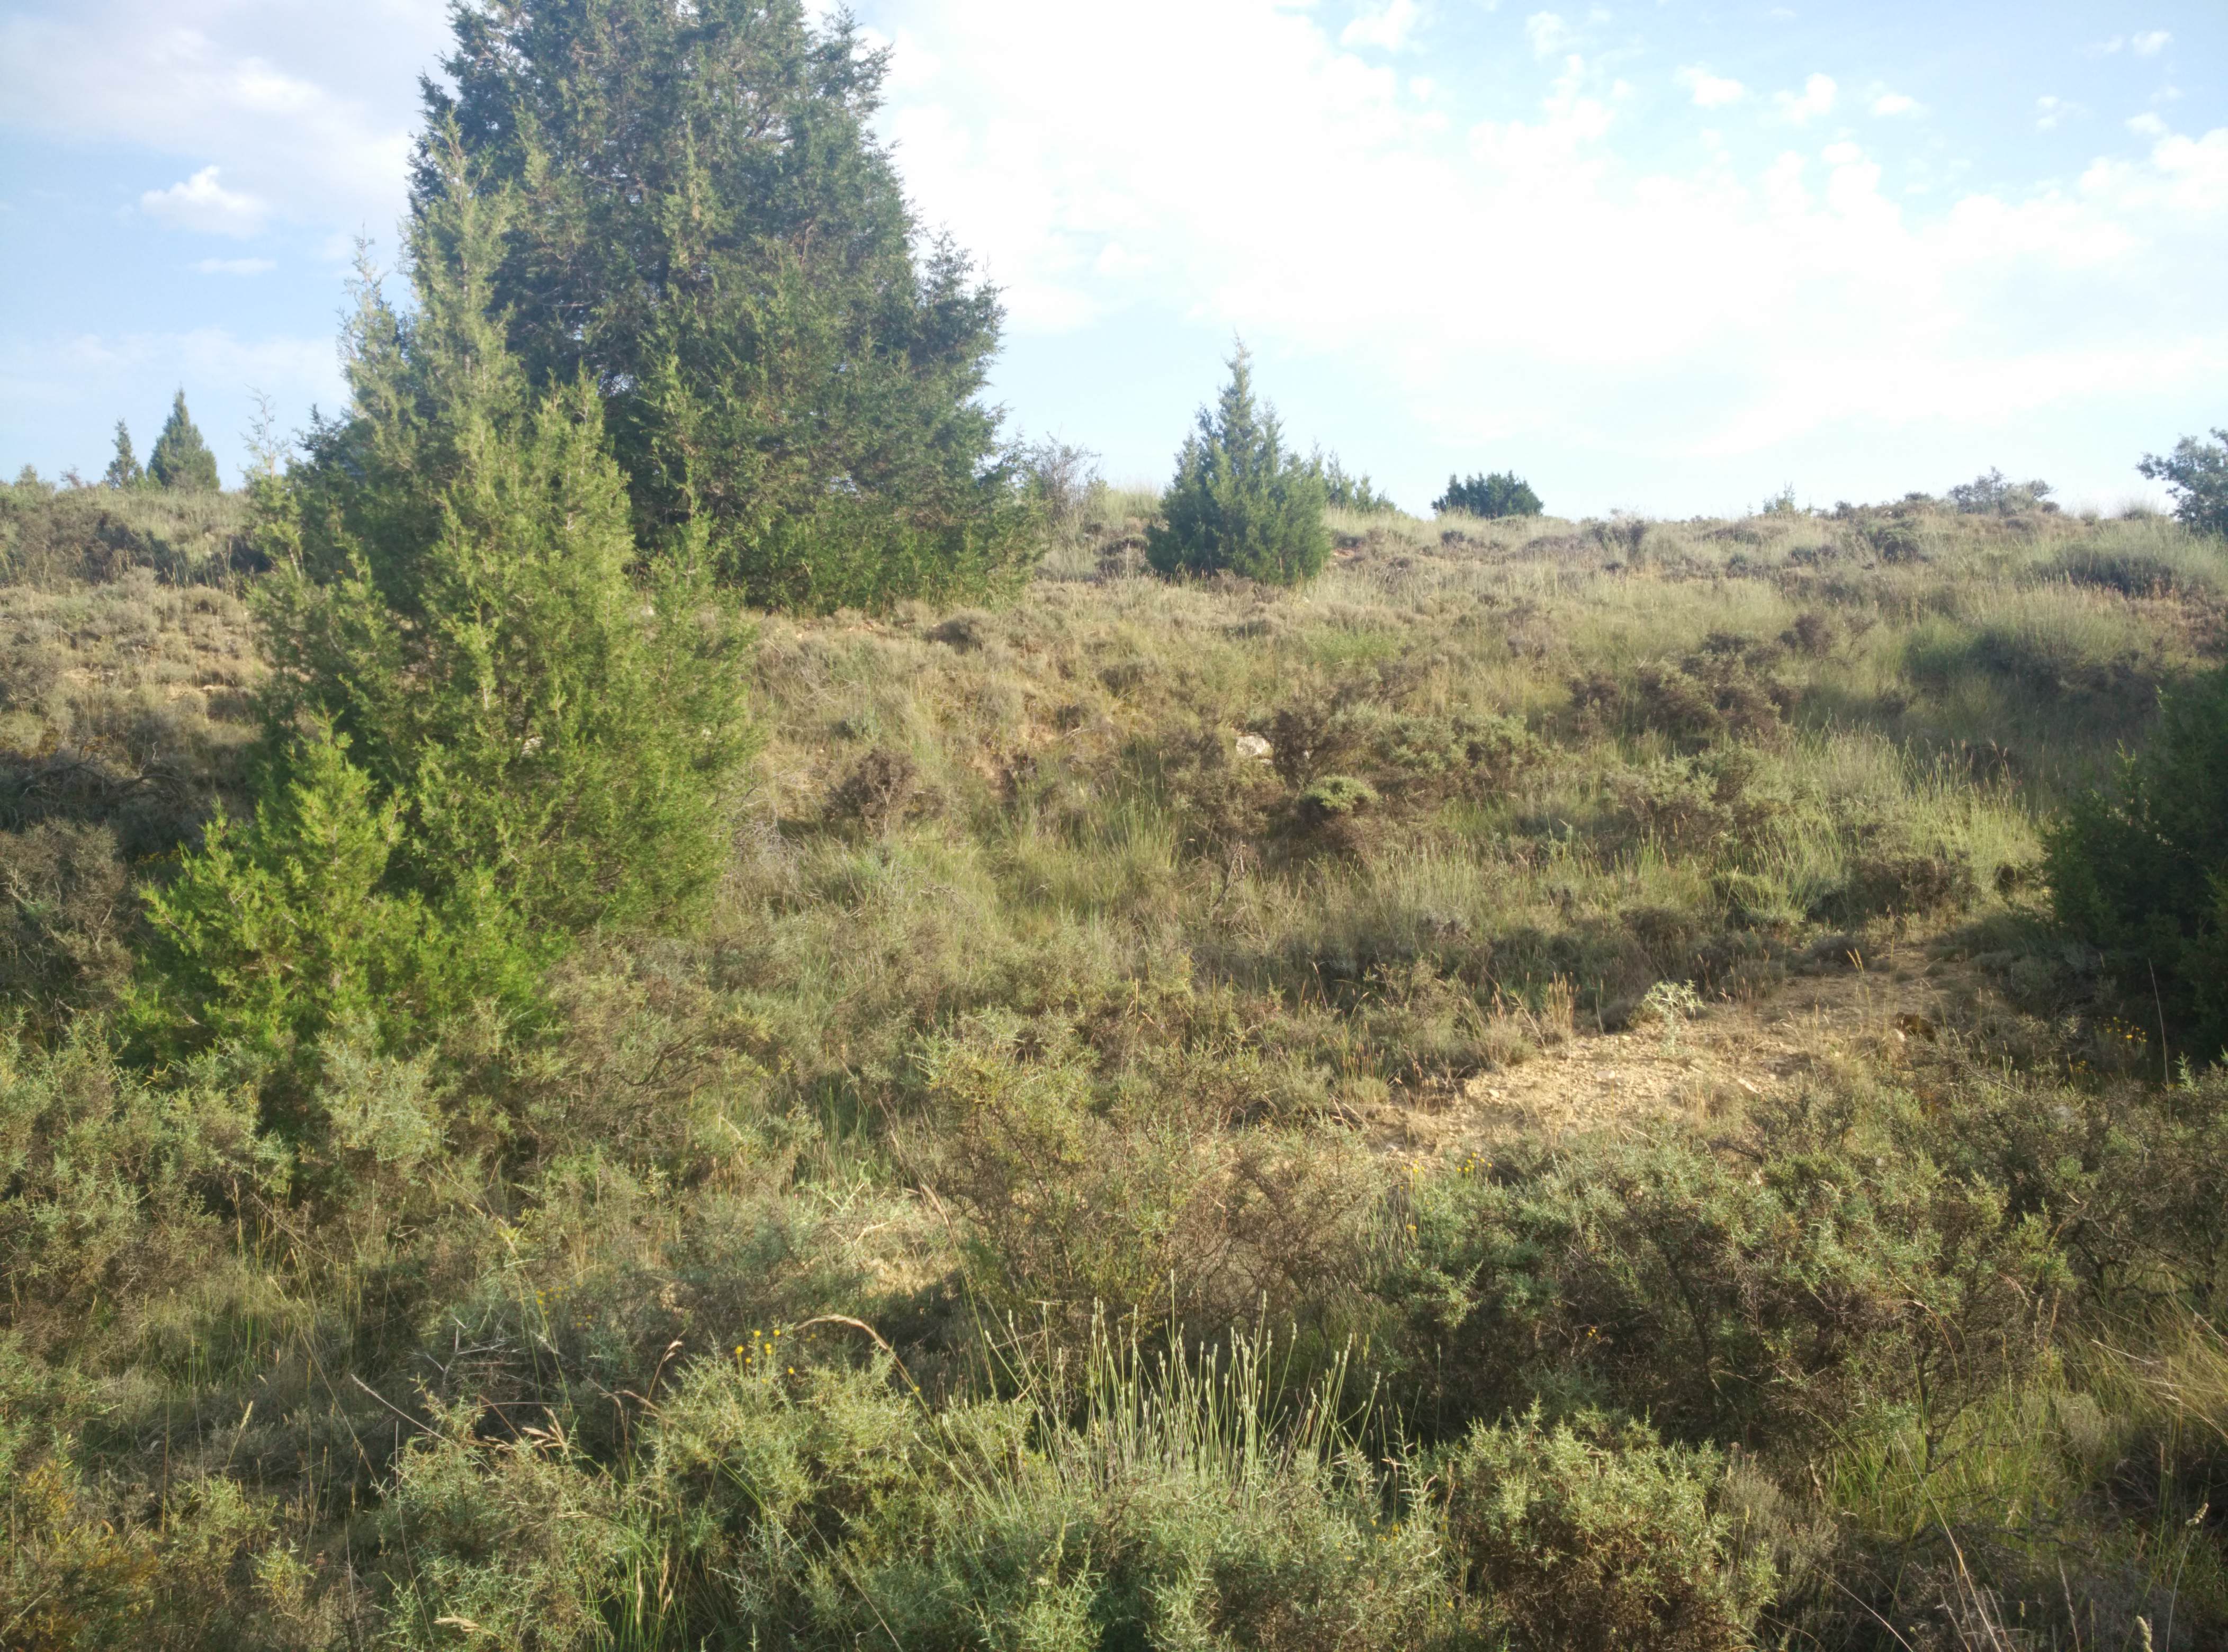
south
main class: Shrubland
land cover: Shrubland with sparse tree cover
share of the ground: > 75 %
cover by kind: shrubs 80 %, unconsolidated bare surface 15 %, coniferous forest trees 5 %
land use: Semi-natural and natural areas not in use
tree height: < 5 m
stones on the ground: 10 - 25 %
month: July
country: ES
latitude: 41.0752
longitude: -1.8910
